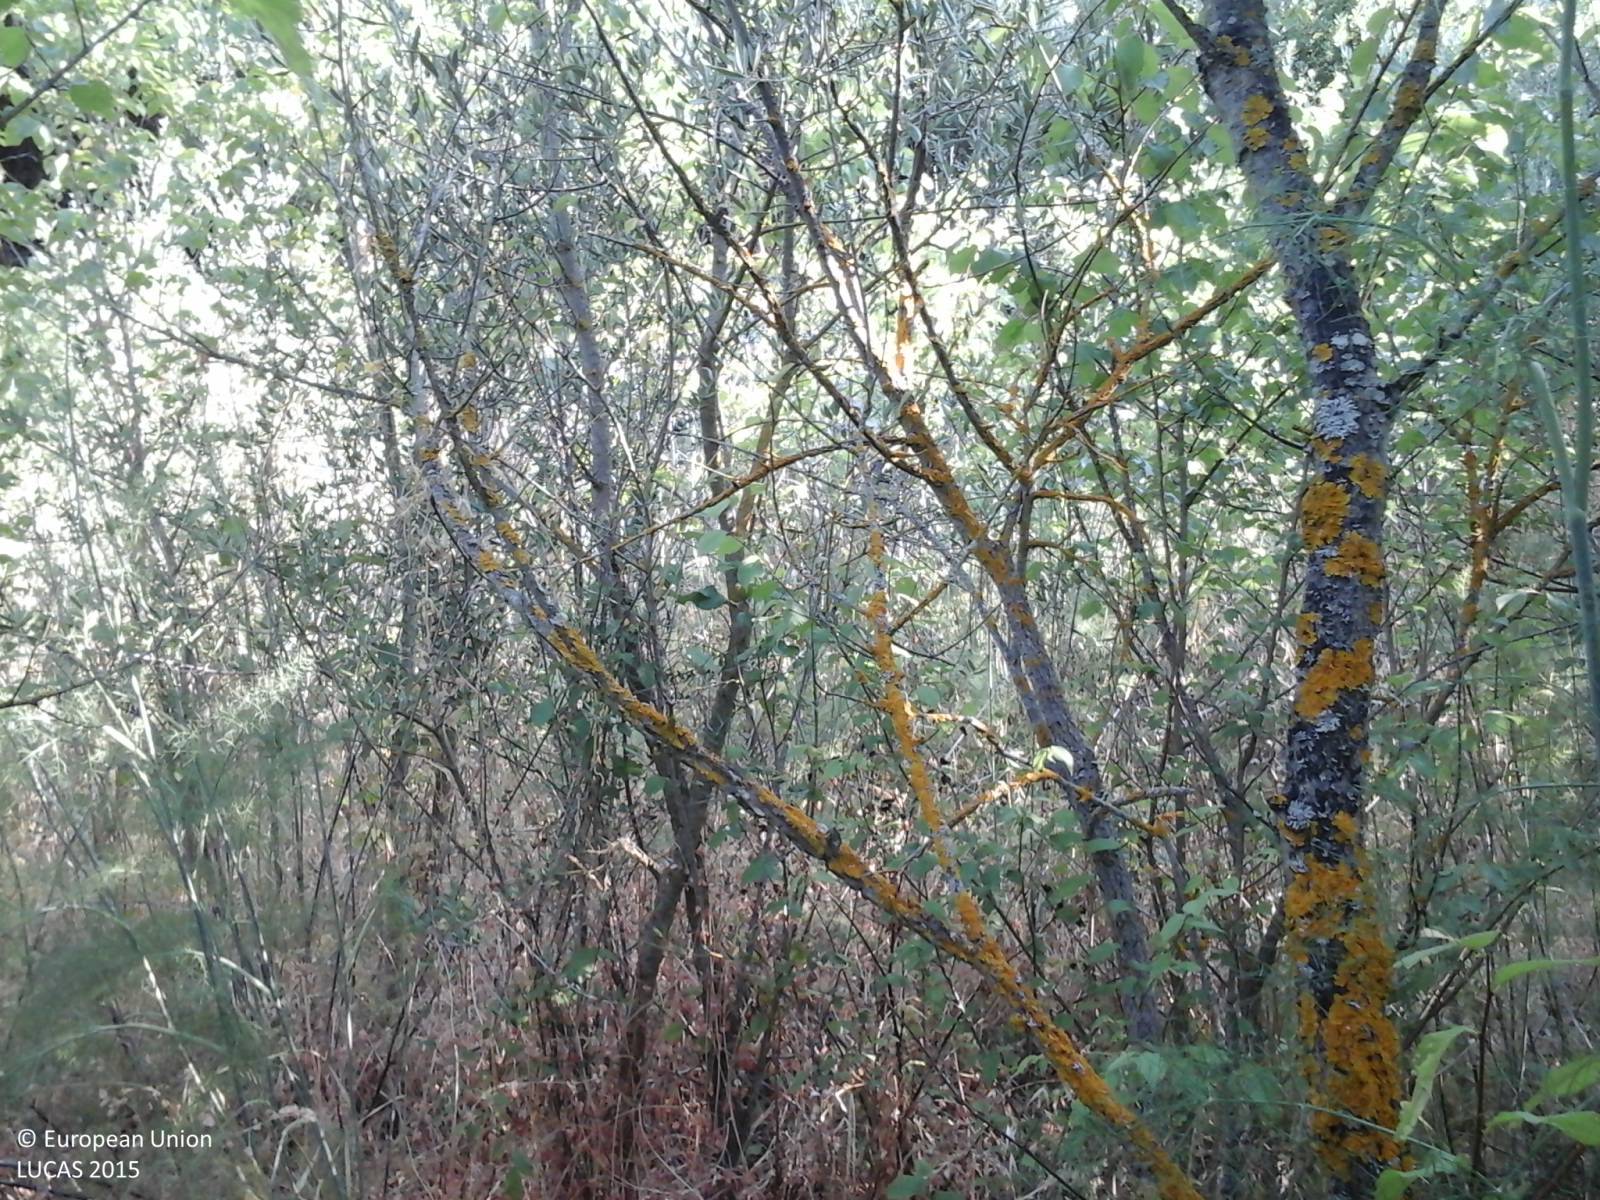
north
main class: Shrubland
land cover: Shrubland with sparse tree cover
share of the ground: > 75 %
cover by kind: shrubs 45 %, herbaceous plants 45 %, broadleaved forest trees 5 %
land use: Semi-natural and natural areas not in use
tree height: < 5 m
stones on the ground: < 10 %
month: June
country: IT
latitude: 40.6746
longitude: 8.6696
